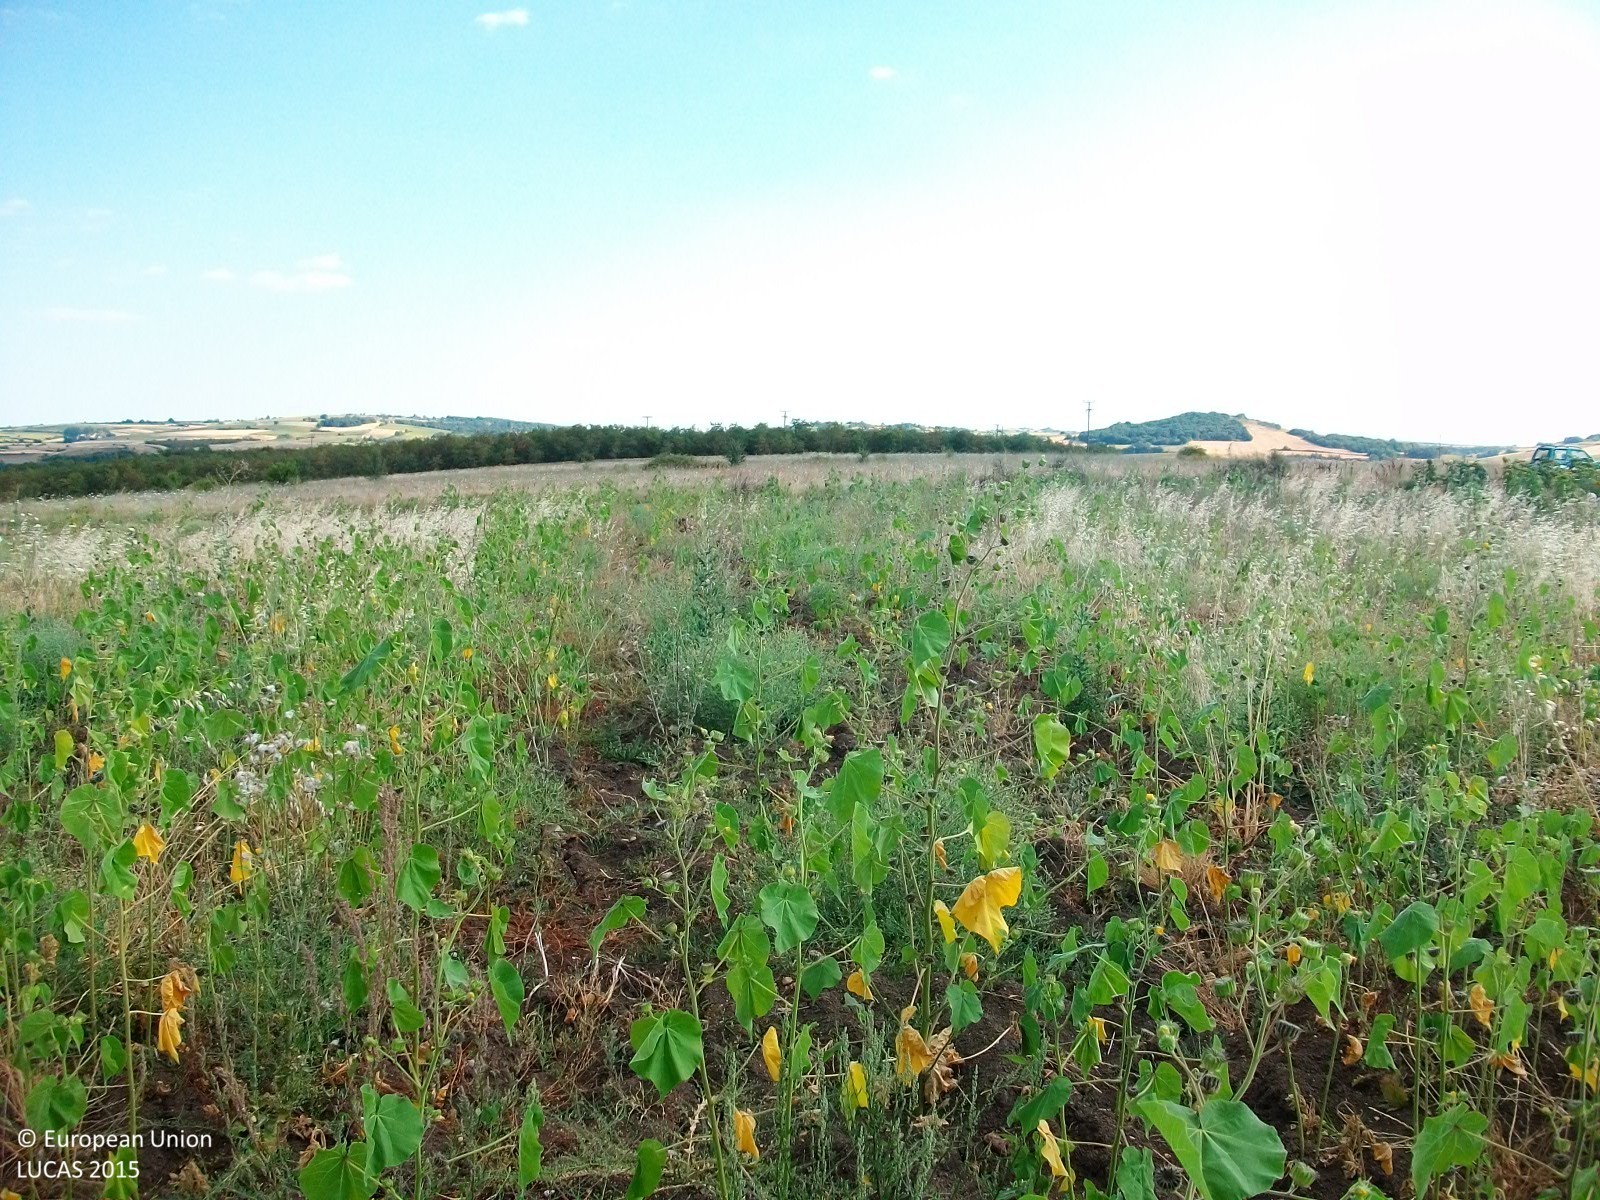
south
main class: Cropland
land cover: Sunflower
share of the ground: > 75 %
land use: Agriculture (excluding fallow land and kitchen gardens)
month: July
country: GR
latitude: 41.5586
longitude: 26.3224
